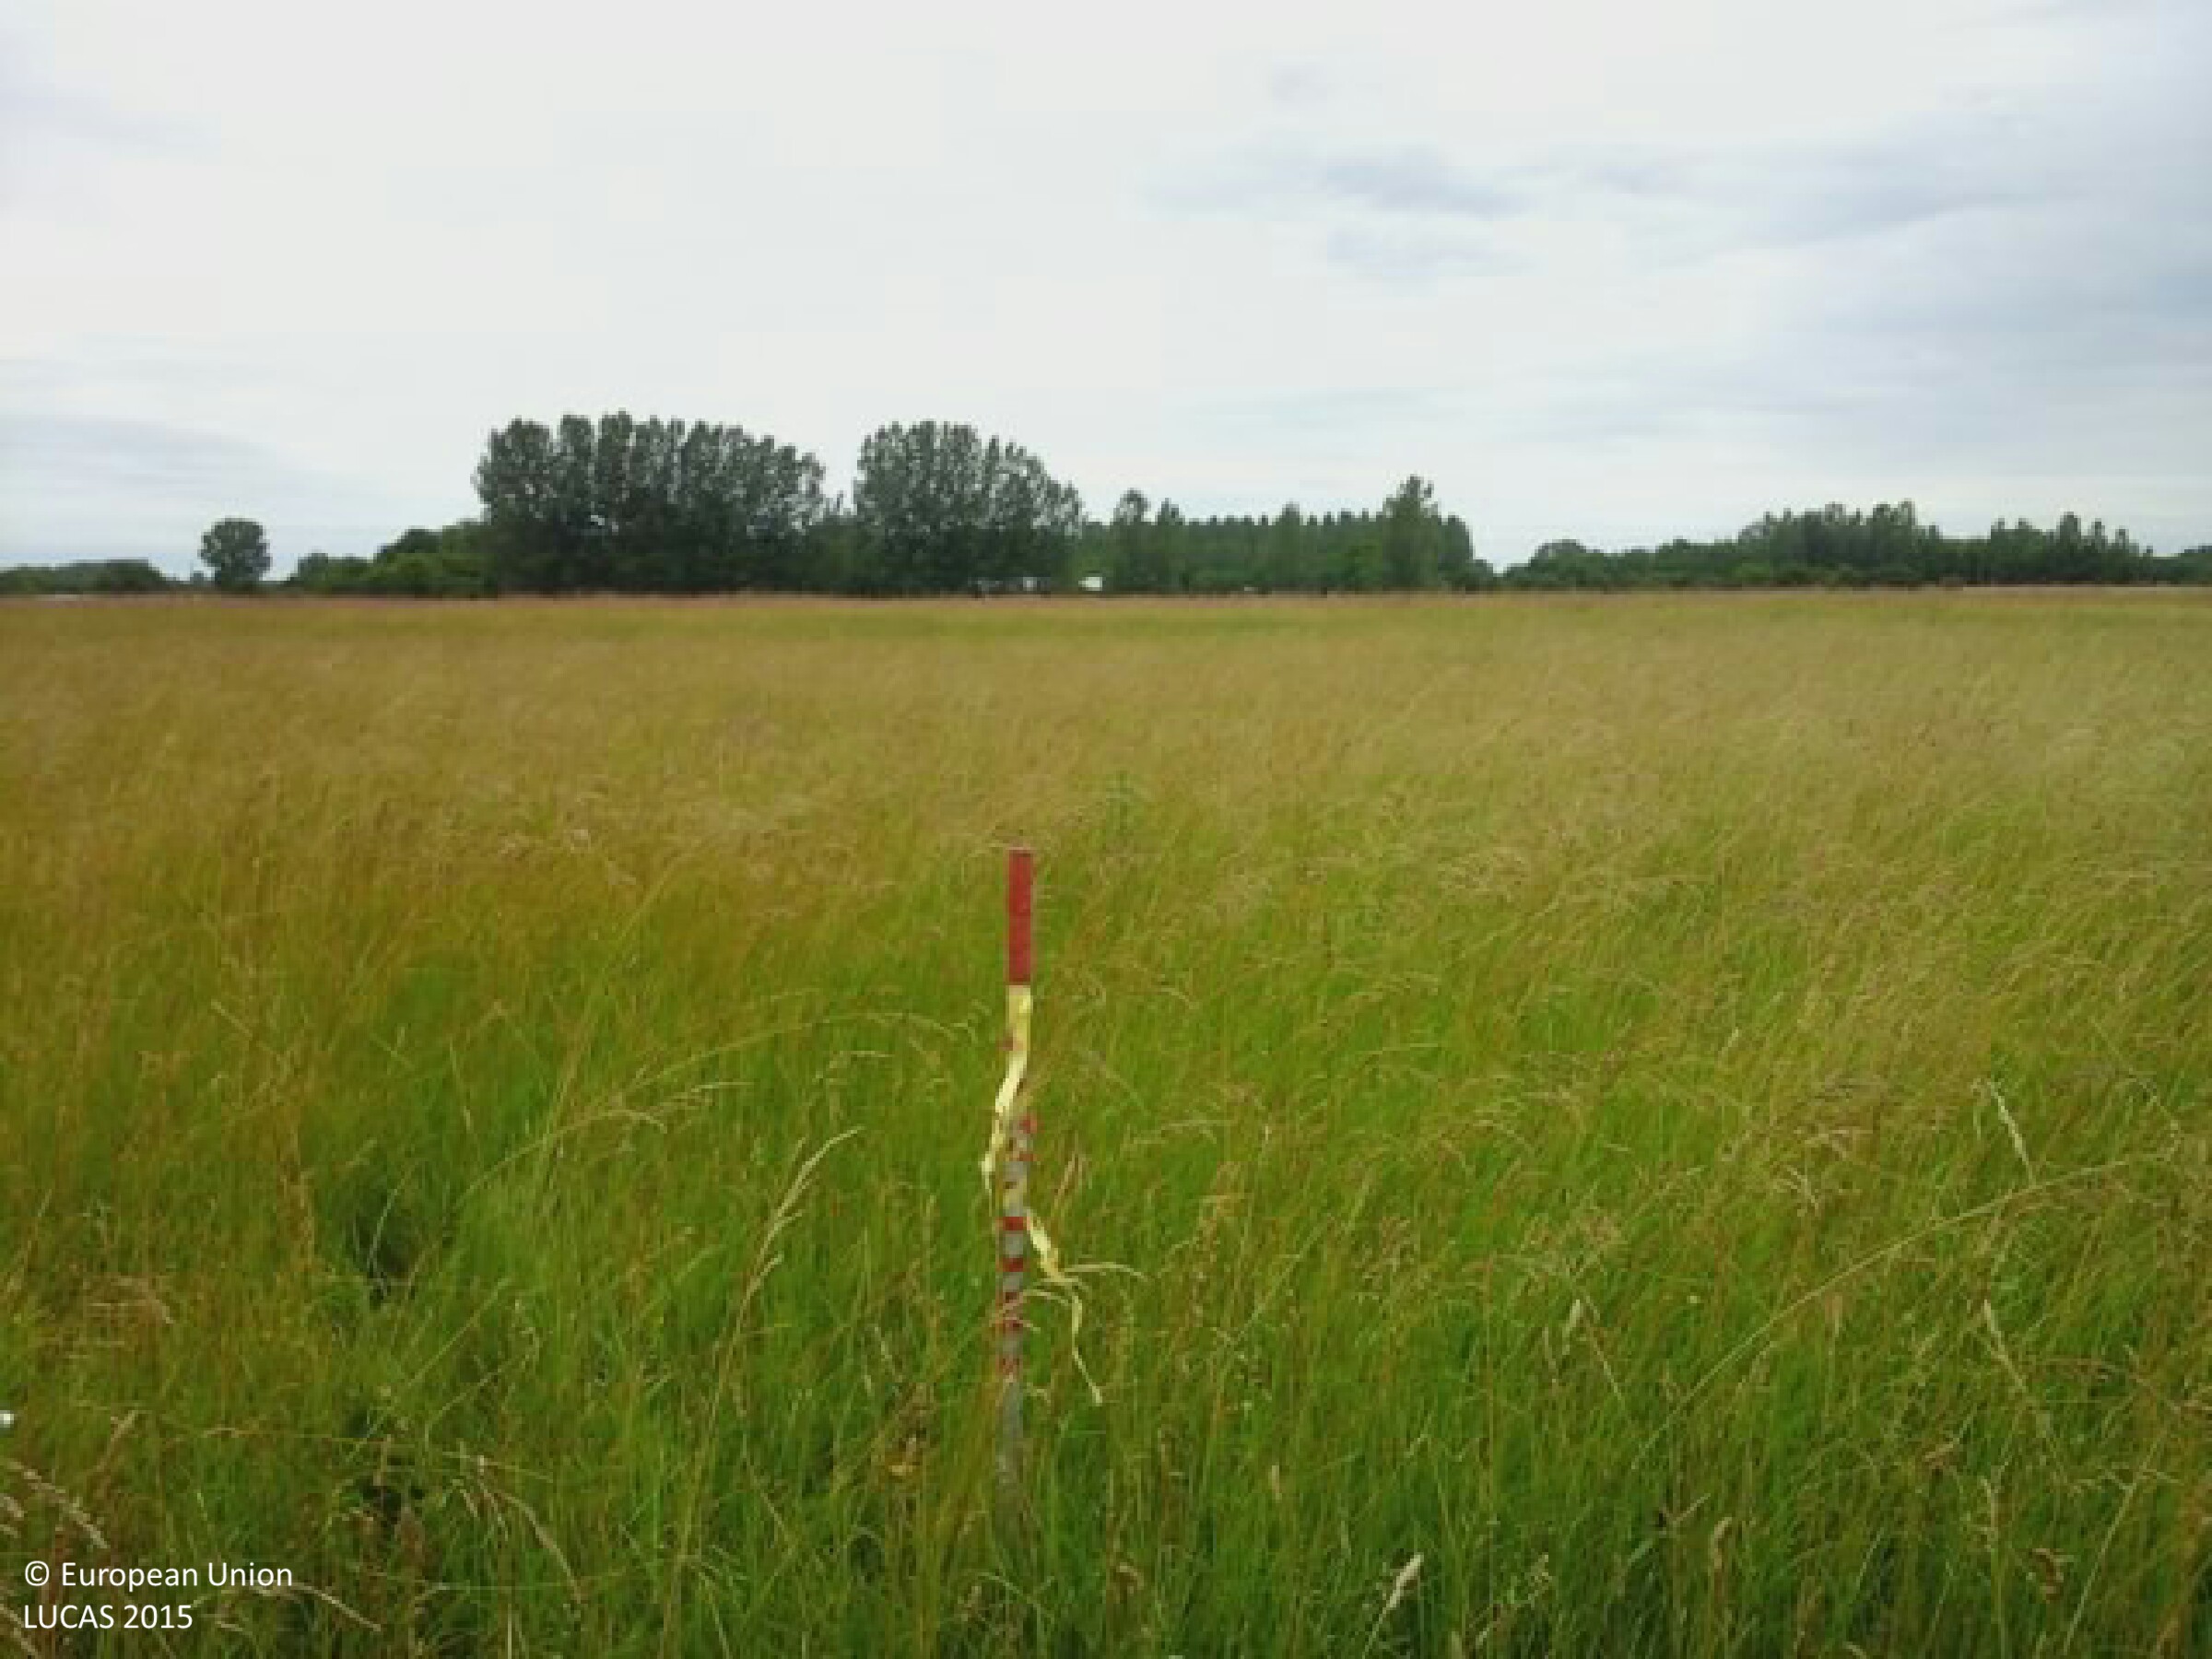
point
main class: Grassland
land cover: Grassland without tree/shrub cover
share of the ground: > 75 %
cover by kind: herbaceous plants 100 %
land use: Agriculture (excluding fallow land and kitchen gardens)
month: June
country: HU
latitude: 46.7201
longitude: 19.5564
